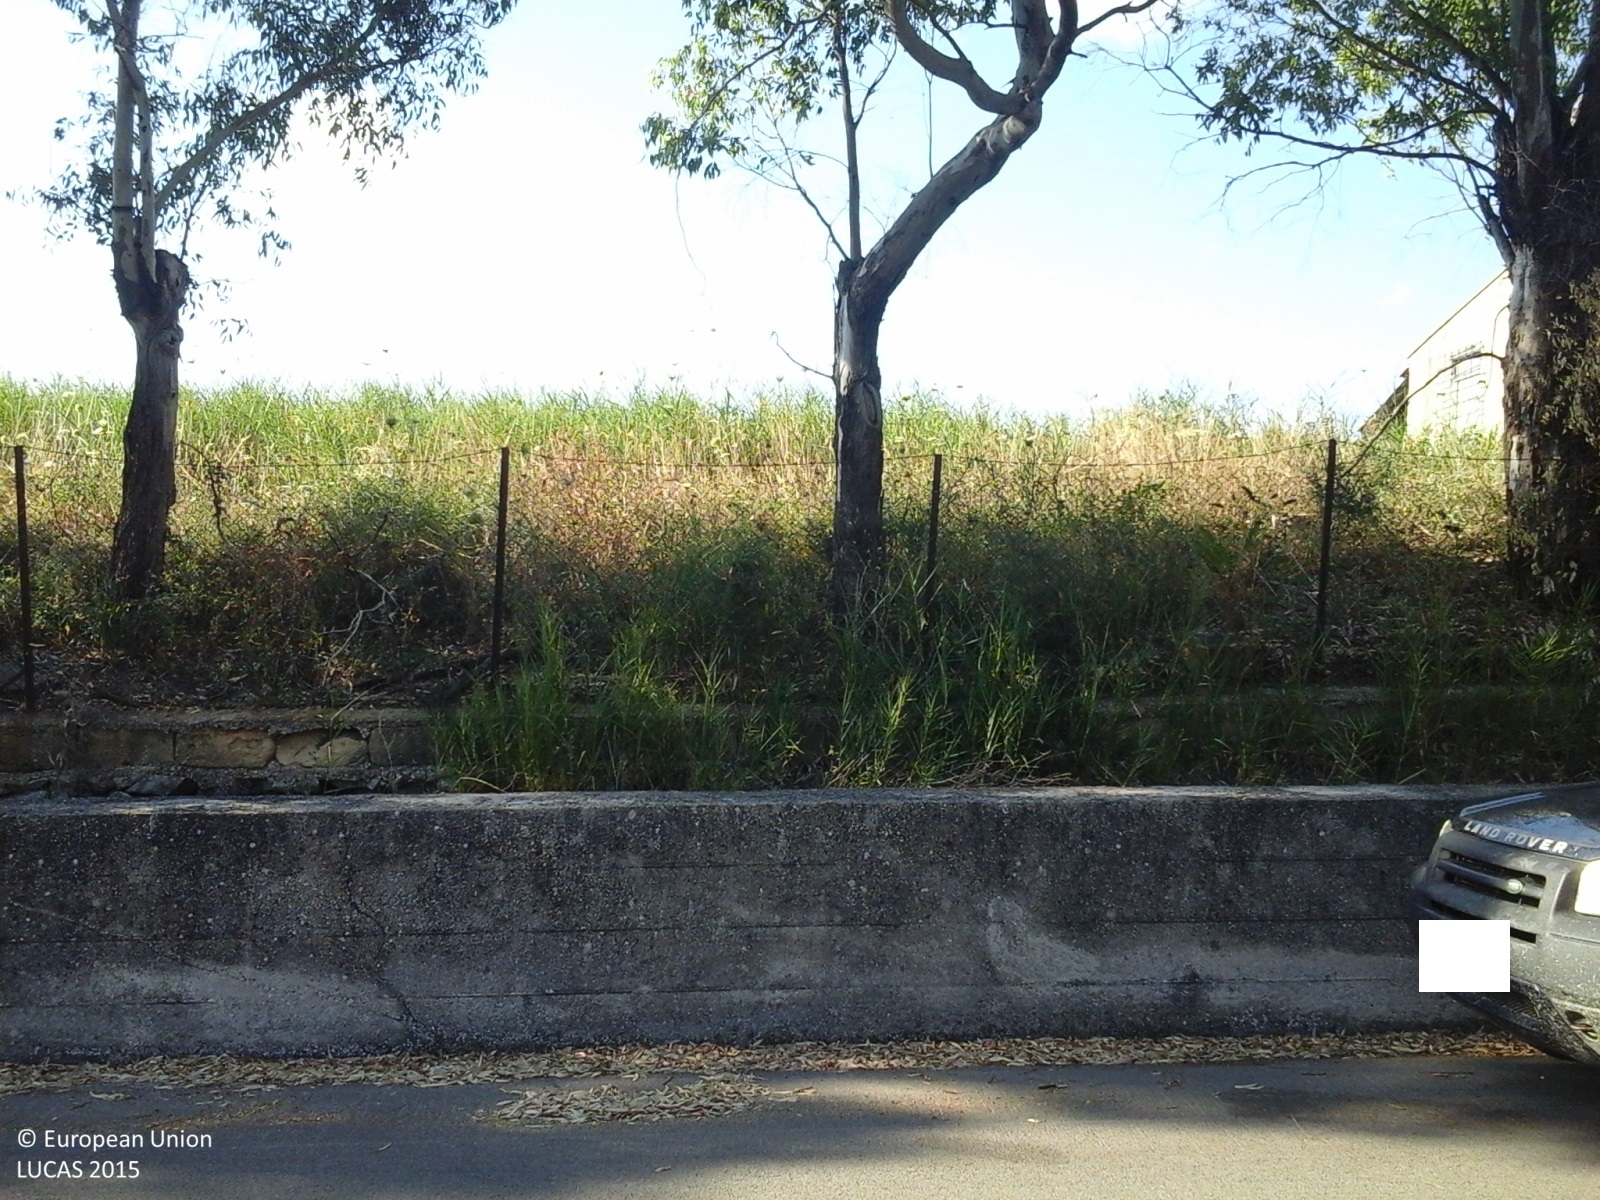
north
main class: Cropland
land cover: Olive groves
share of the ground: 50 - 75 %
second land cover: Other bare soil
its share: > 75 %
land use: Agriculture (excluding fallow land and kitchen gardens)
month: June
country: IT
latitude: 37.9913
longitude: 13.5163
